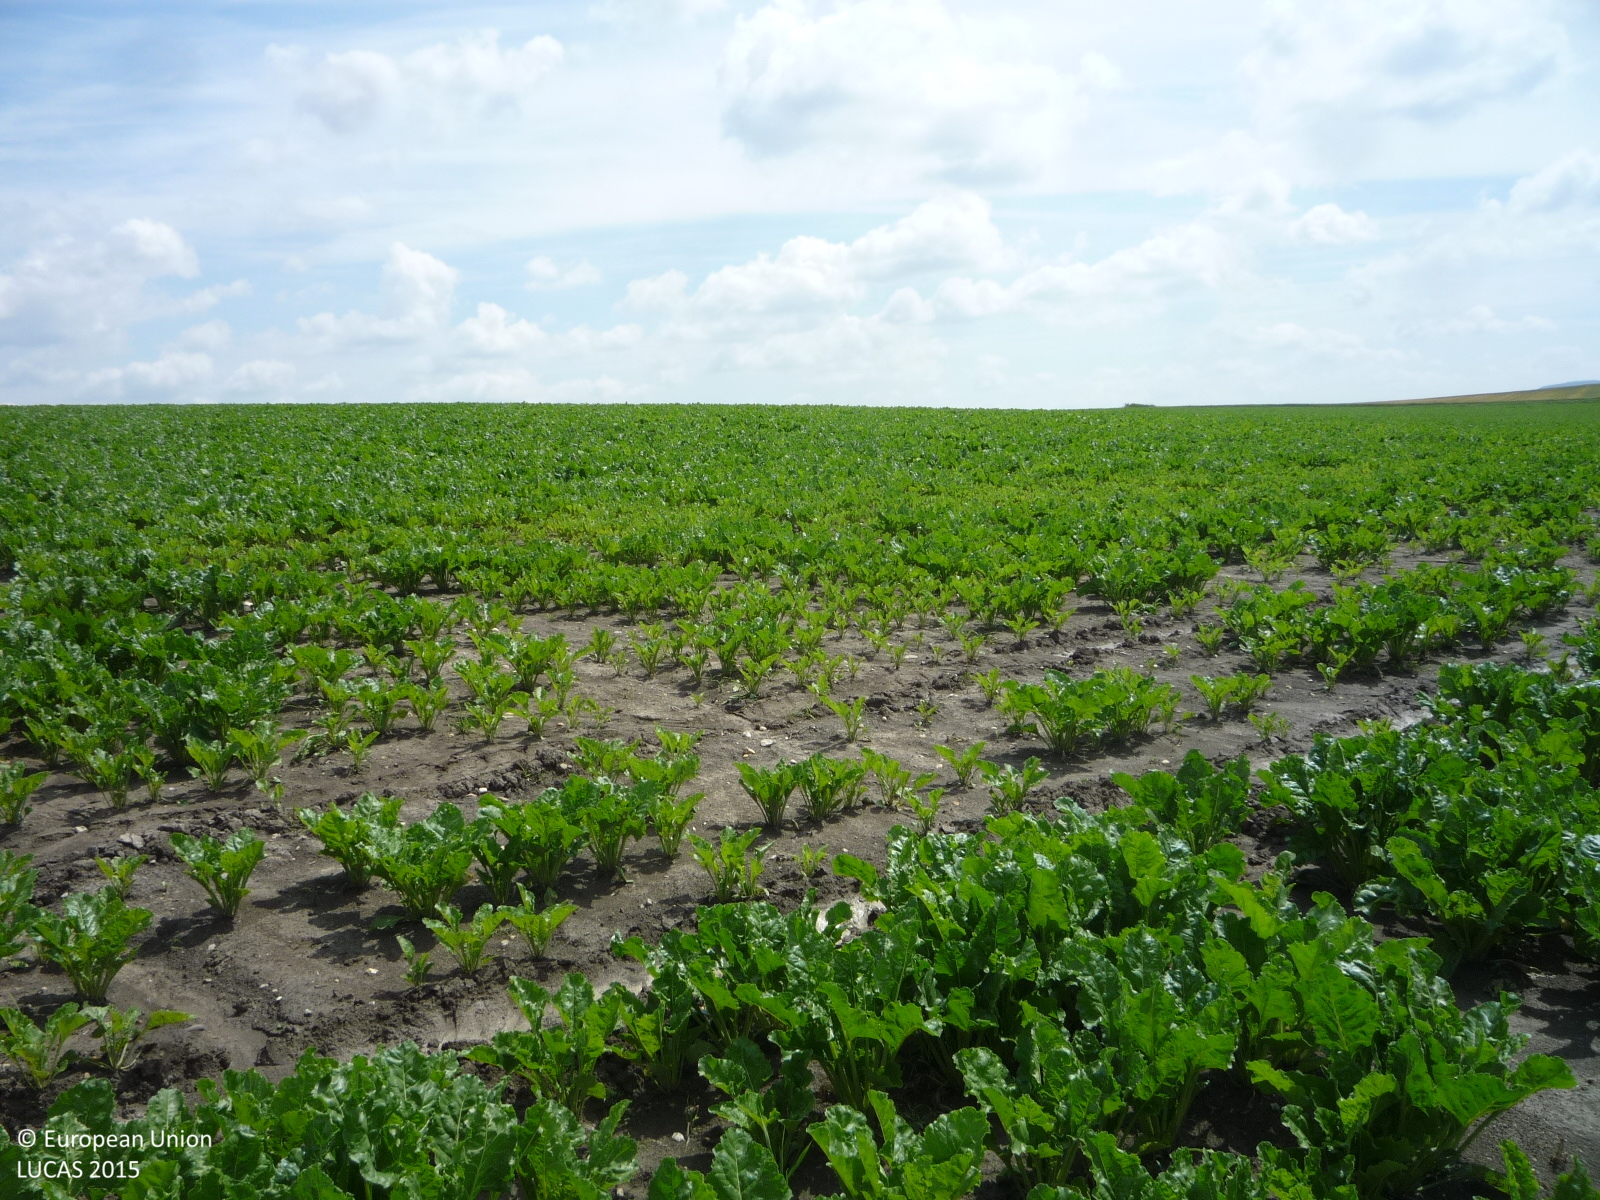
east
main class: Cropland
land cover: Sugar beet
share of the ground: > 75 %
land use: Agriculture (excluding fallow land and kitchen gardens)
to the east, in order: Sugar beet; Common wheat
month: June
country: CZ
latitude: 50.4317
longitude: 14.1824
